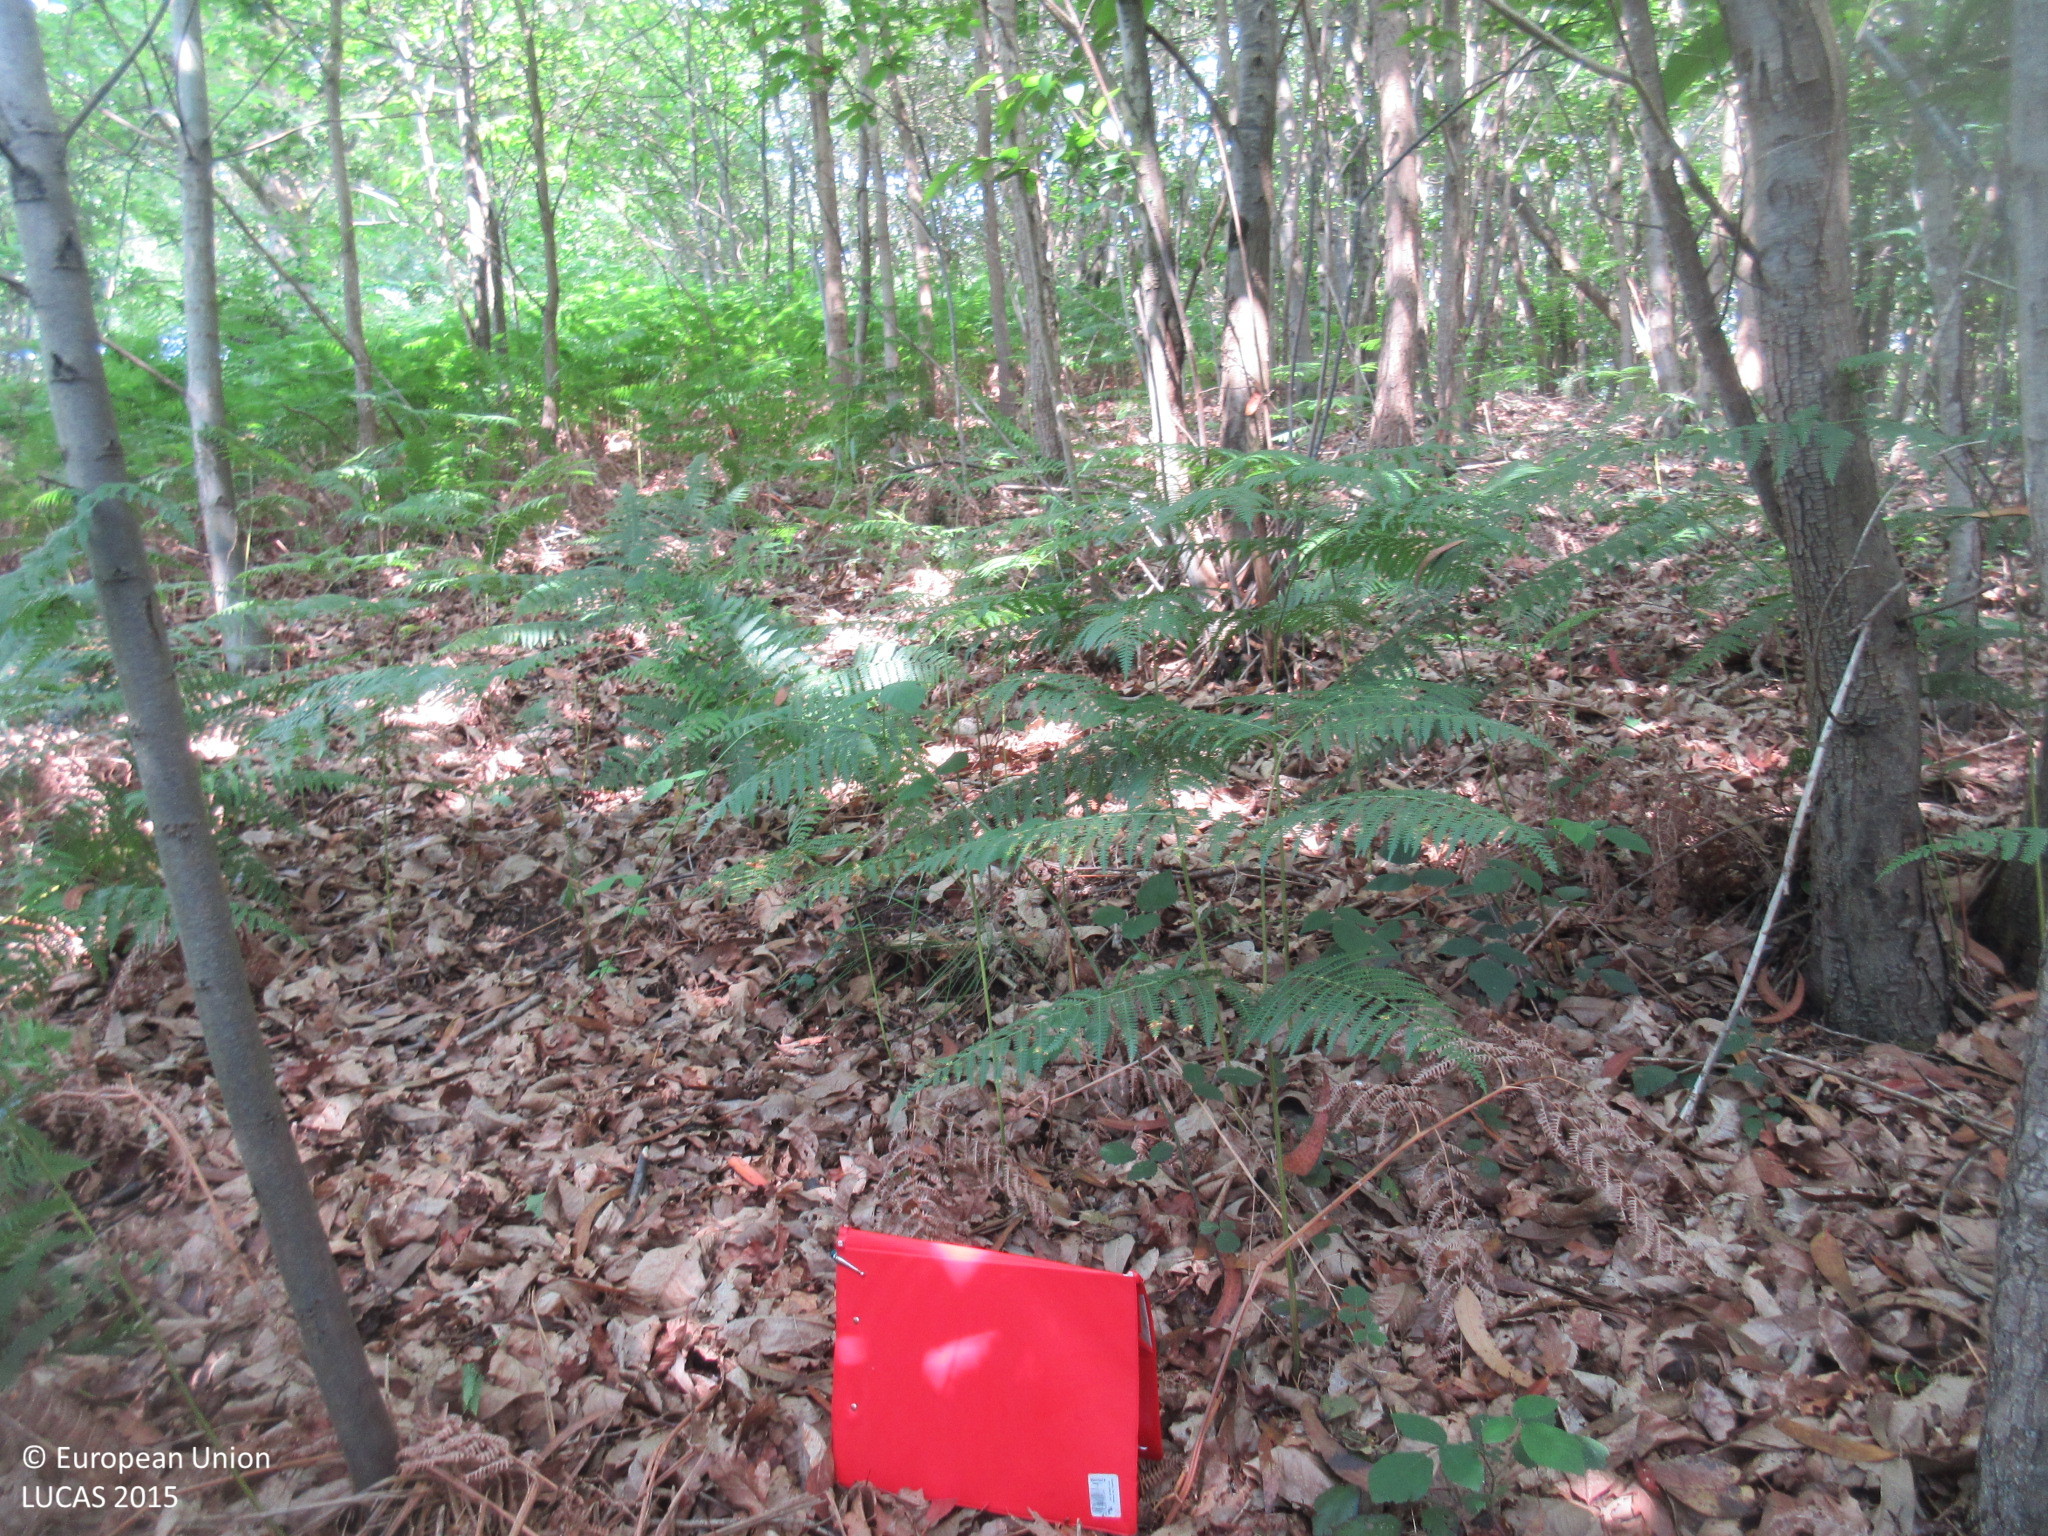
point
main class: Woodland
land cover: Broadleaved woodland
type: thermophilous deciduous forest
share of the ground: > 75 %
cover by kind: broadleaved forest trees 95 %, shrubs 5 %
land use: Forestry
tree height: > 5 m
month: June
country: ES
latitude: 43.4175
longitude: -5.9615
